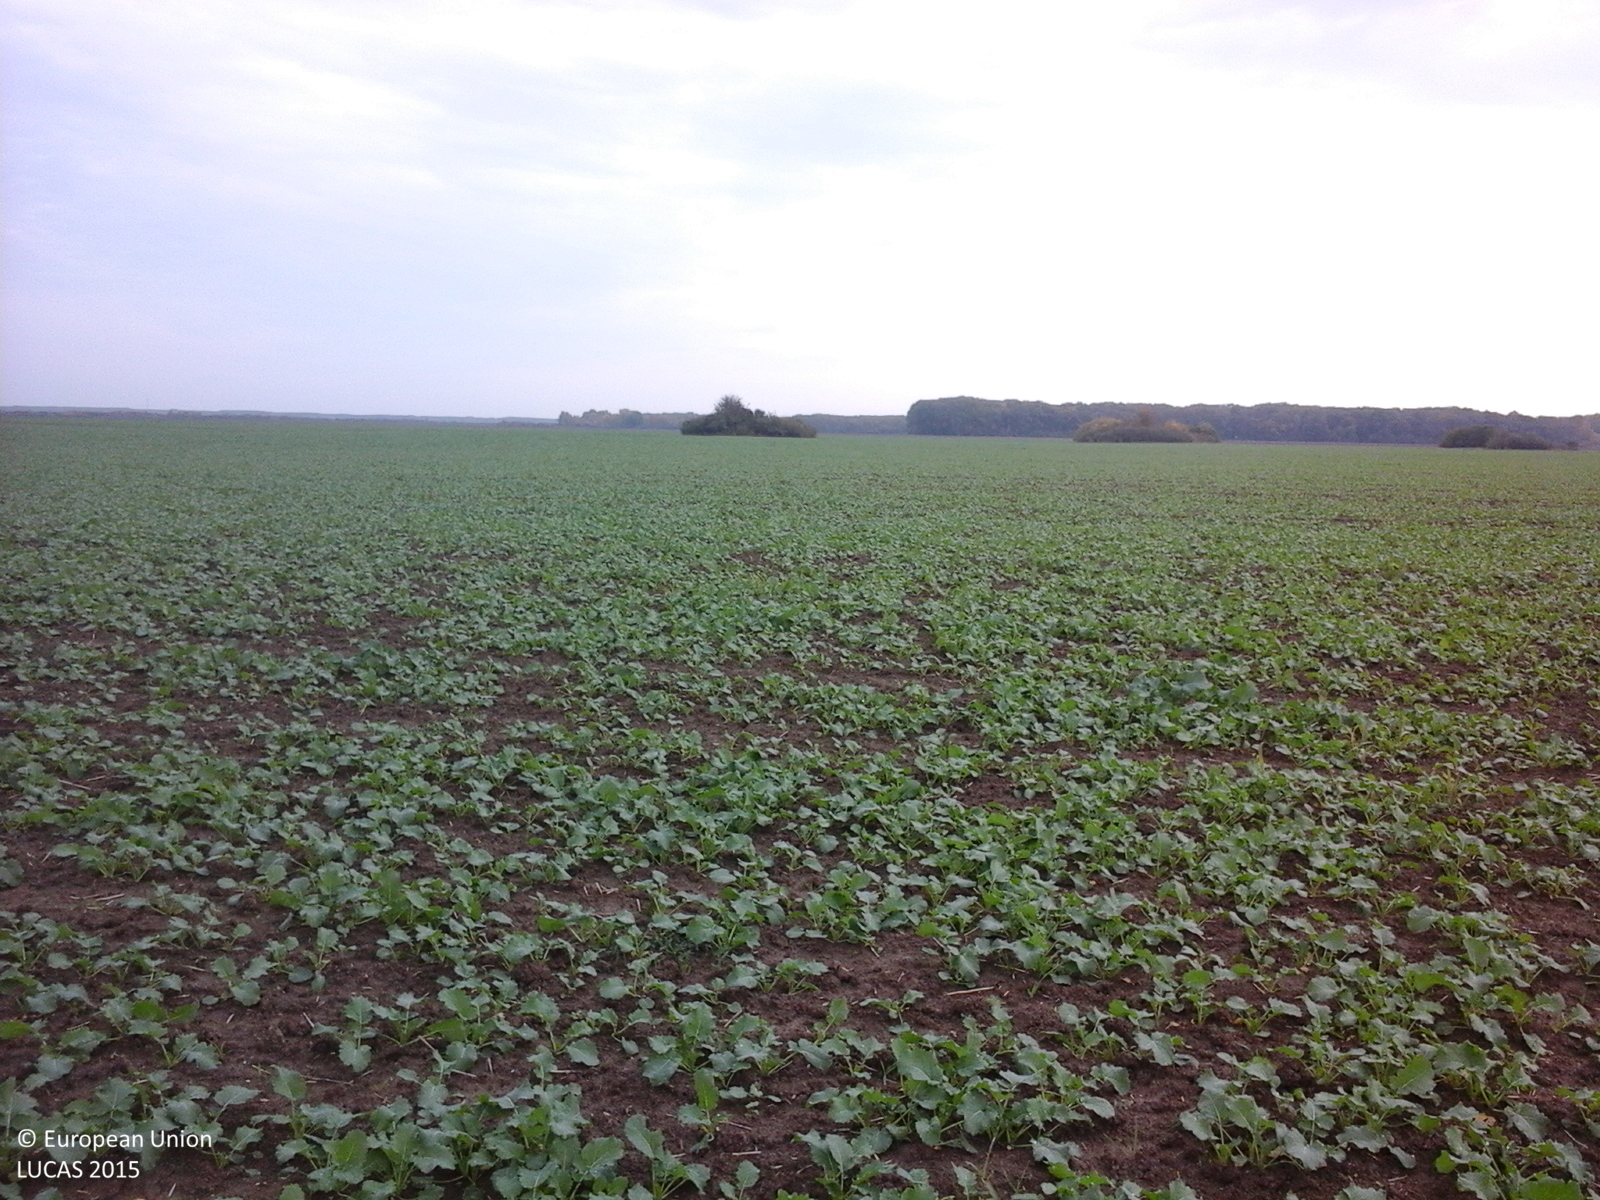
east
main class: Cropland
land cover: Rape and turnip rape
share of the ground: > 75 %
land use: Agriculture (excluding fallow land and kitchen gardens)
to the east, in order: Rape and turnip rape
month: October
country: RO
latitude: 44.8049
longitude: 26.1282
